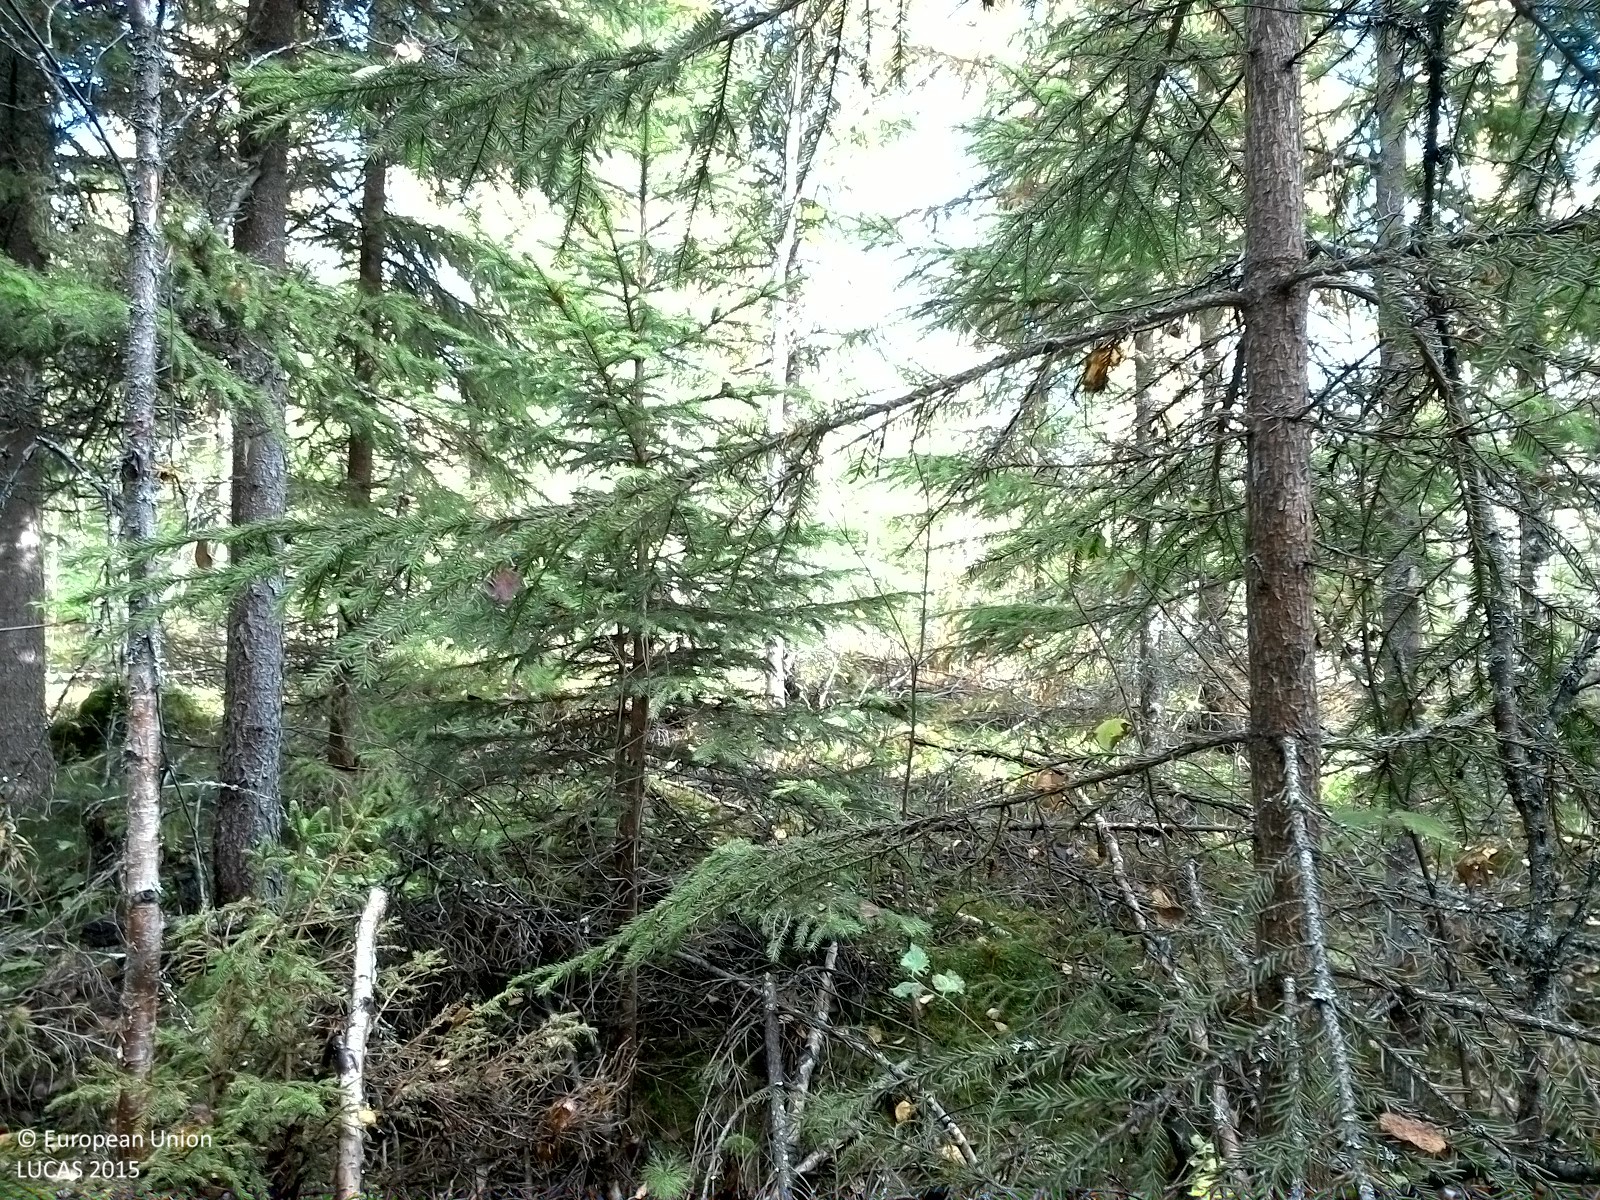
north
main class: Woodland
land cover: Spruce dominated mixed woodland
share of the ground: > 75 %
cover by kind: coniferous forest trees 55 %, broadleaved forest trees 30 %, herbaceous plants 10 %, lichens and mosses 5 %
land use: Forestry
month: September
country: SE
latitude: 62.1762
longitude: 16.2223
